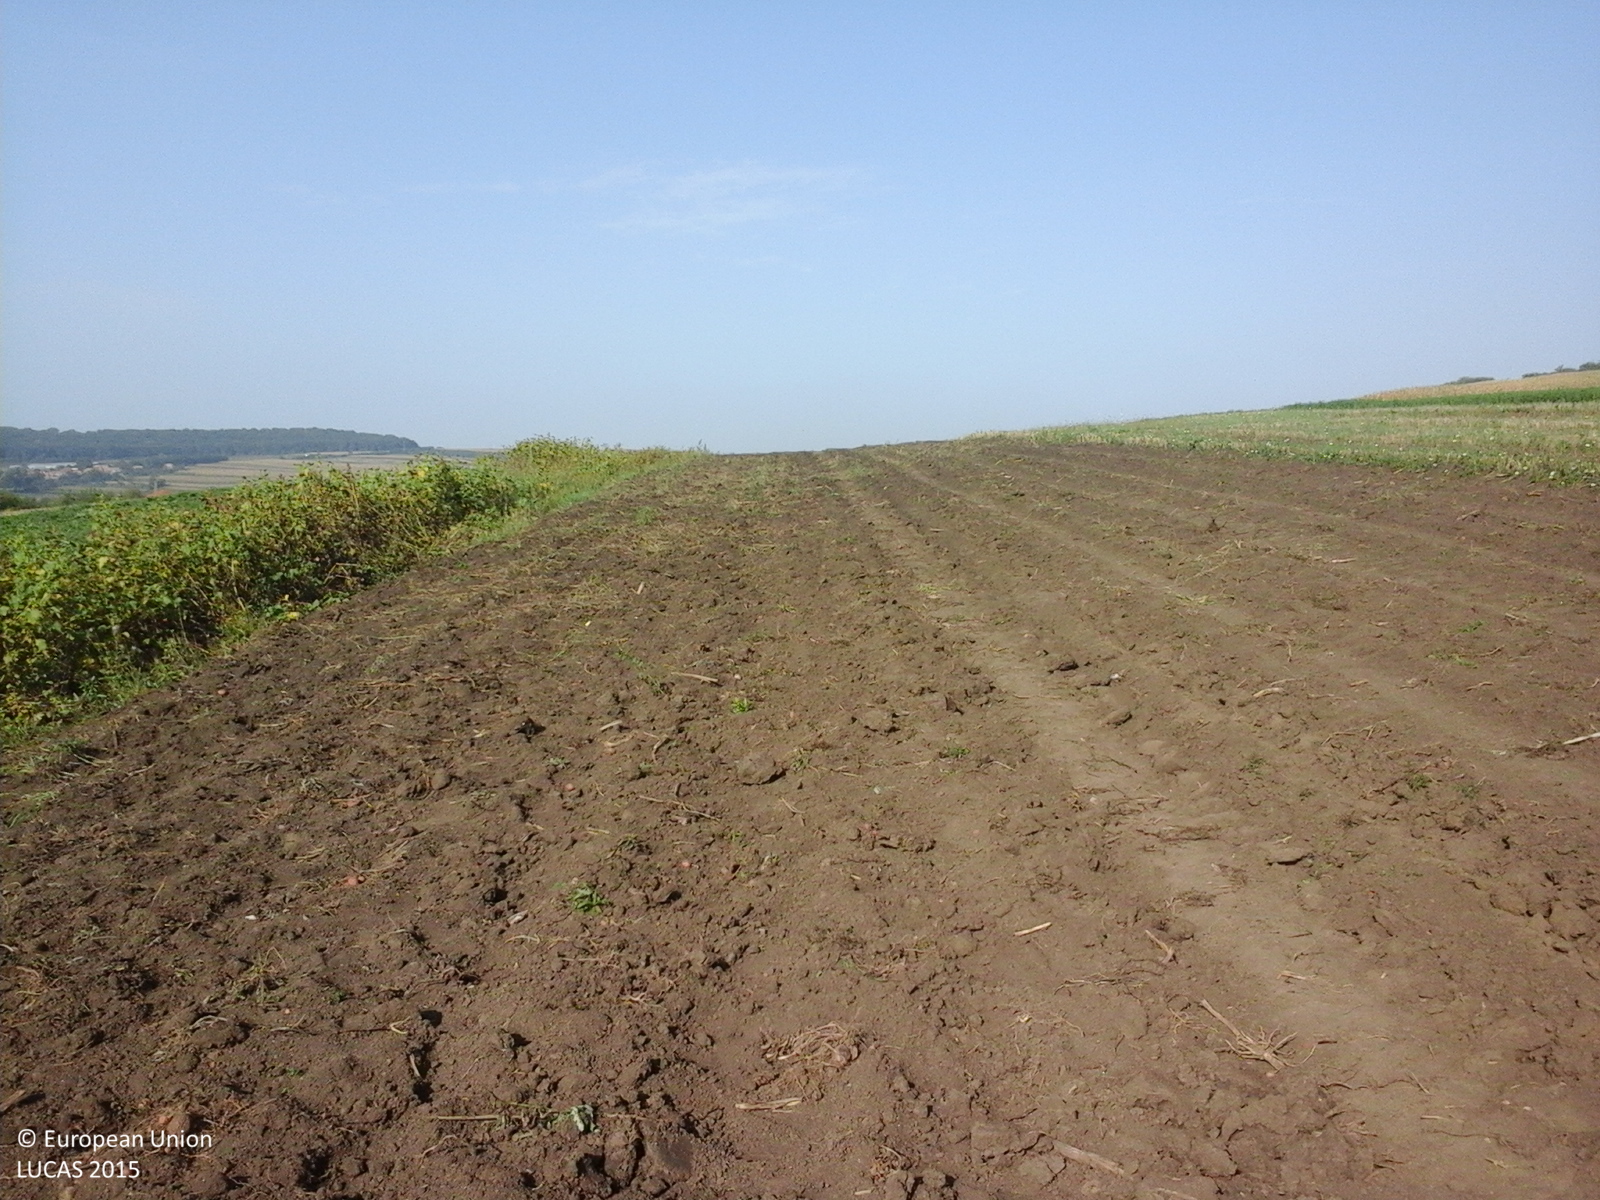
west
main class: Cropland
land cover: Potatoes
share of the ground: < 10 %
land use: Agriculture (excluding fallow land and kitchen gardens)
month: September
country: RO
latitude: 46.6111
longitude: 24.0095
